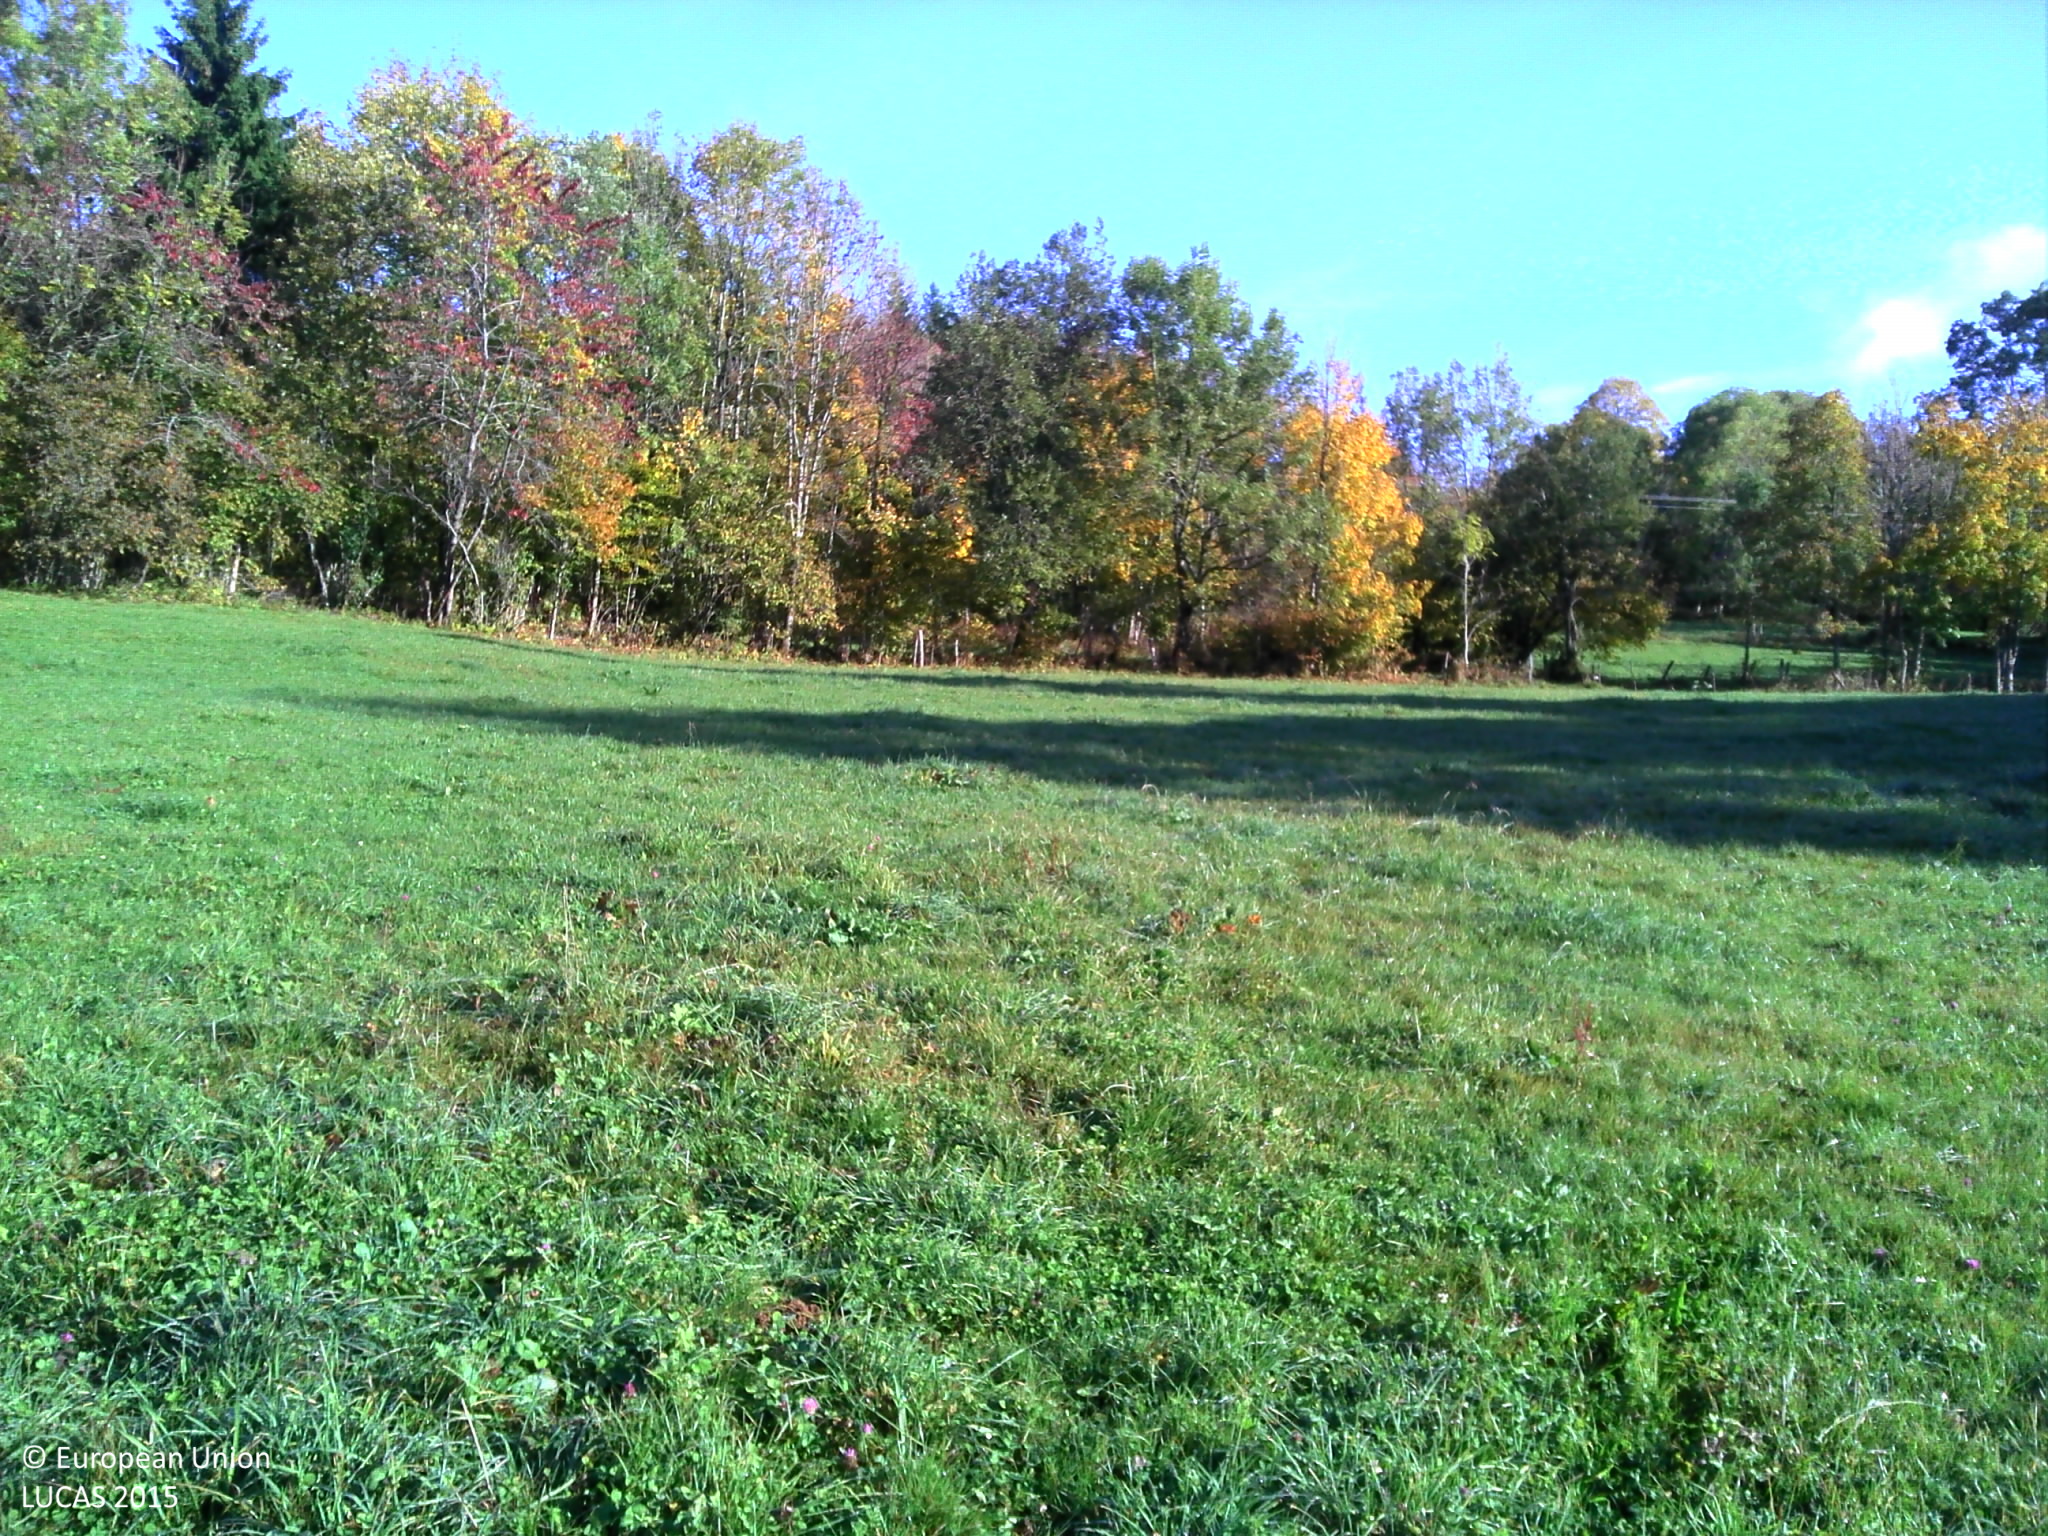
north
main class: Grassland
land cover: Grassland without tree/shrub cover
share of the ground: > 75 %
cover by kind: herbaceous plants 100 %
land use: Agriculture (excluding fallow land and kitchen gardens)
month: October
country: FR
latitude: 46.8853
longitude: 6.3936
